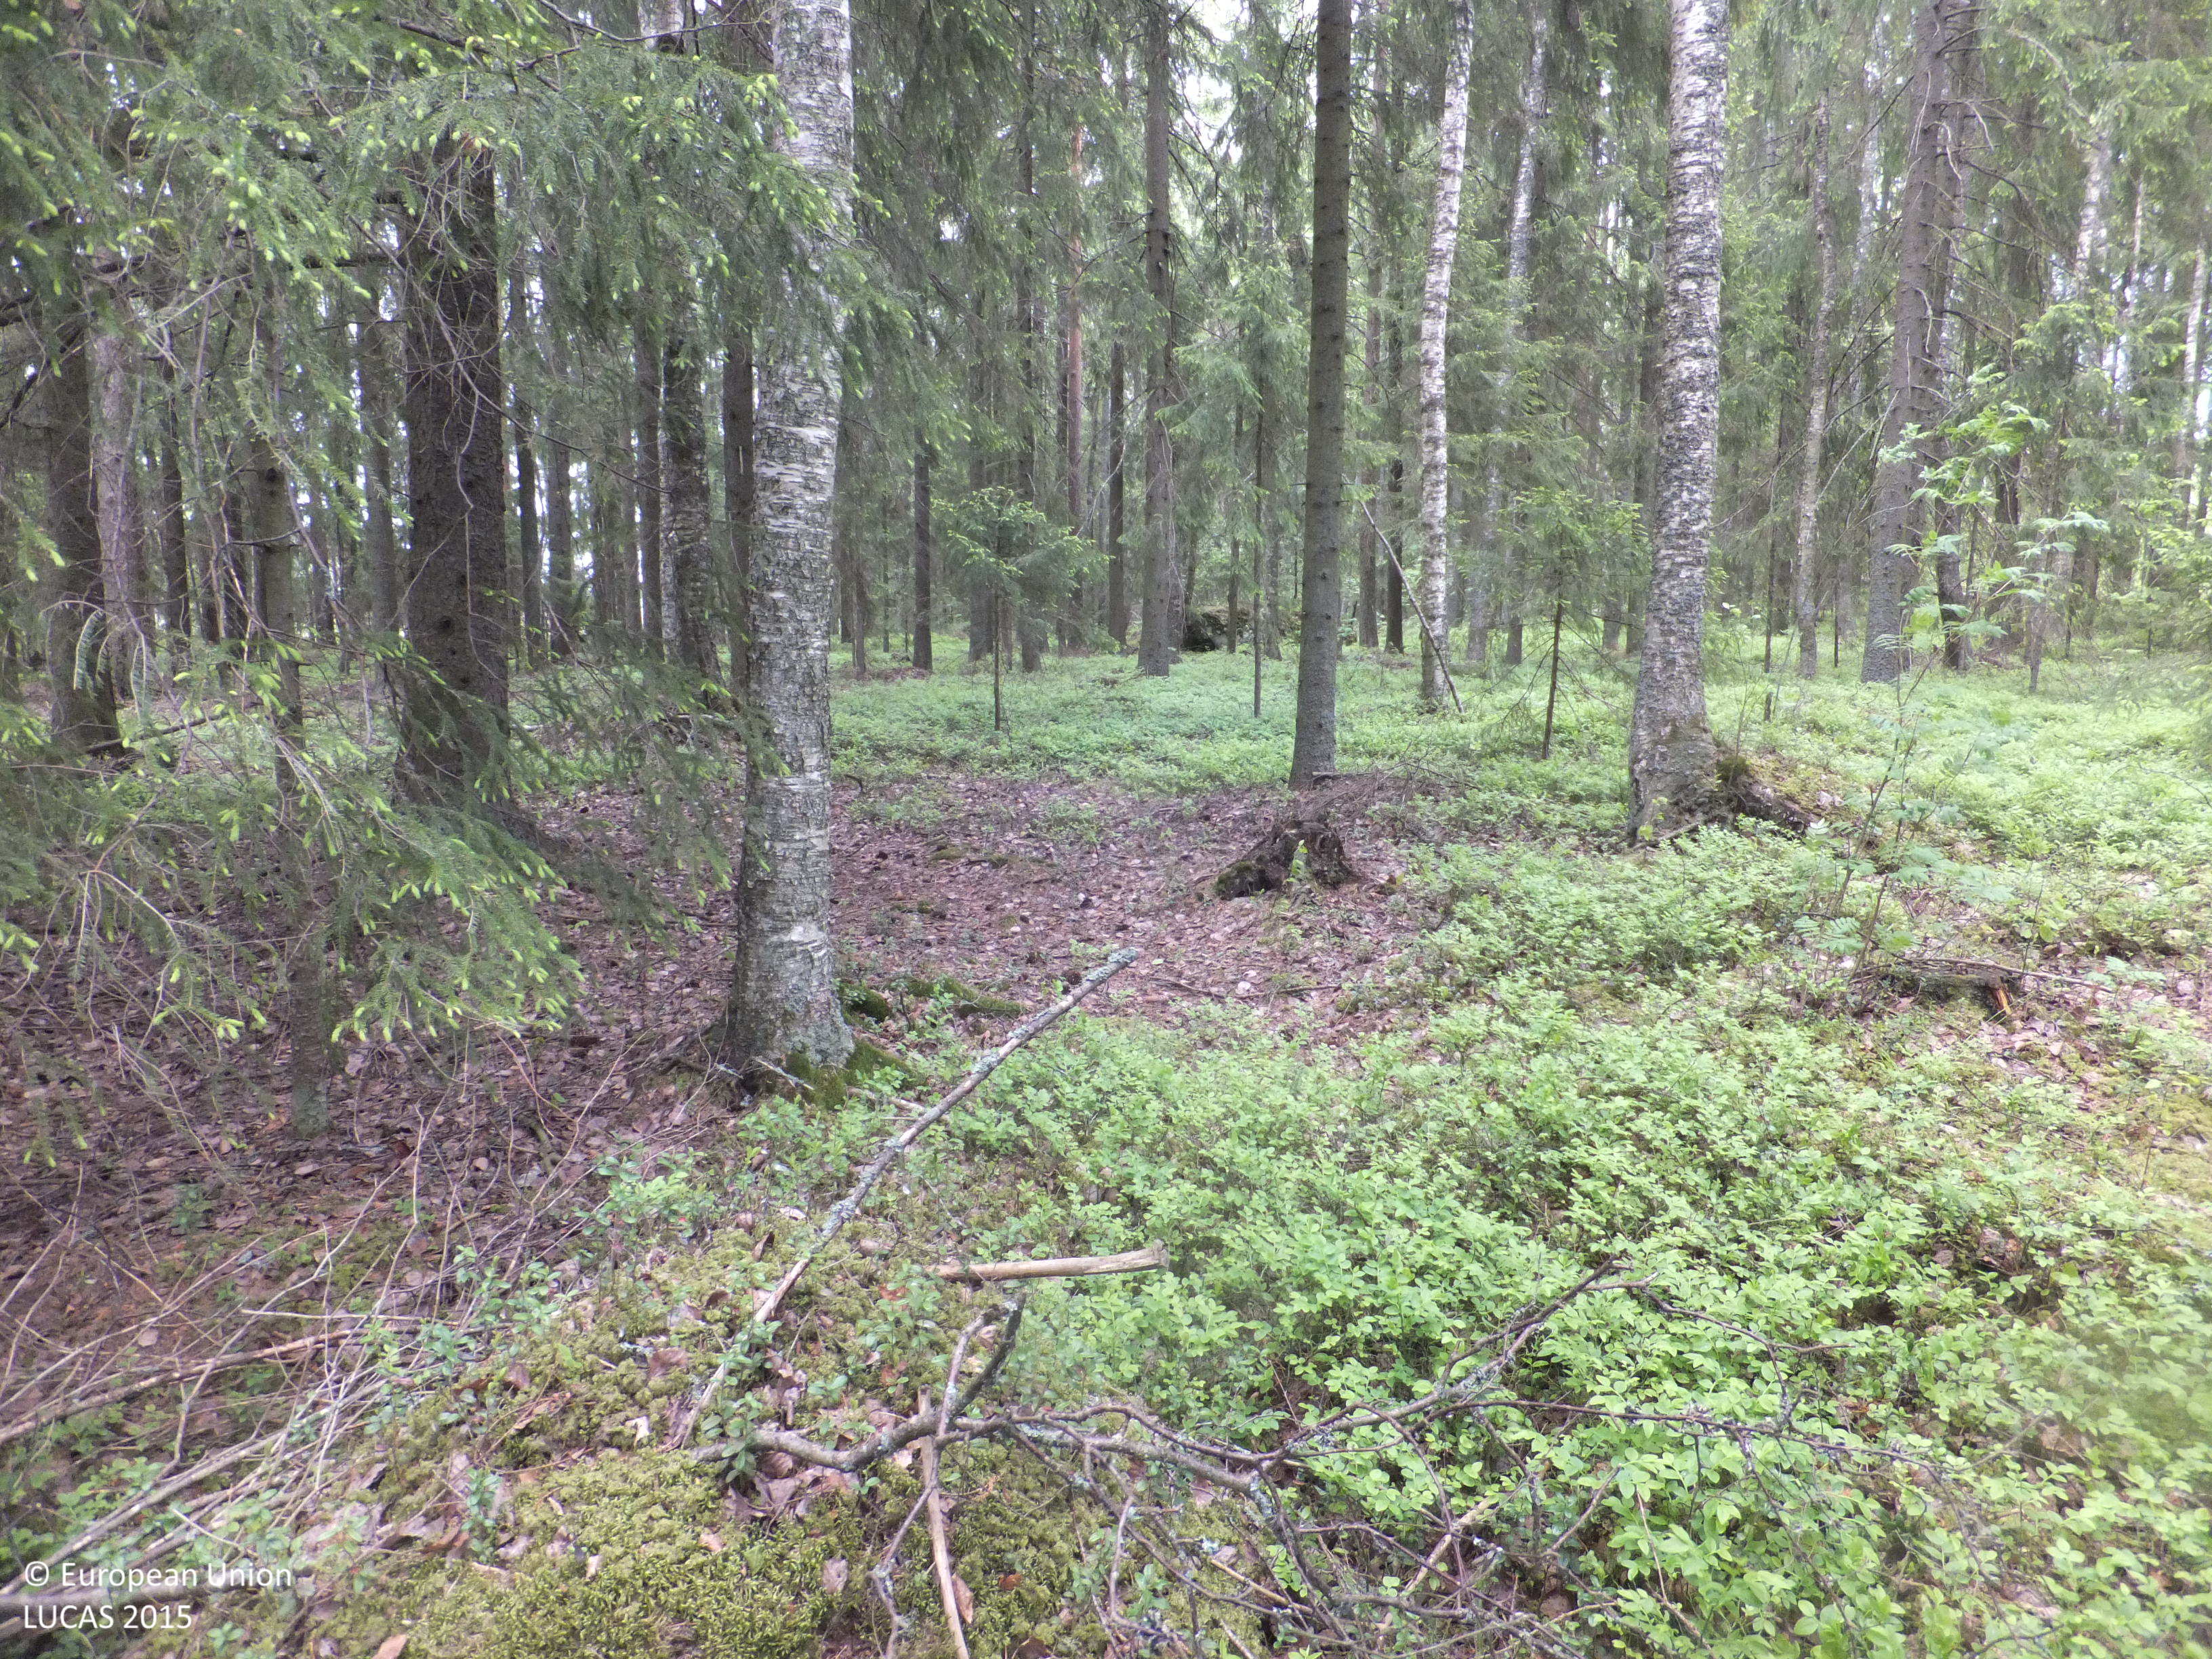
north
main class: Woodland
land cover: Spruce dominated mixed woodland
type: boreal forest
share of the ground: > 75 %
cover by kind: coniferous forest trees 55 %, broadleaved forest trees 20 %, shrubs 10 %, lichens and mosses 10 %, herbaceous plants 5 %
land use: Forestry
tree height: > 5 m
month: June
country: FI
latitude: 63.1866
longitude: 22.5089
